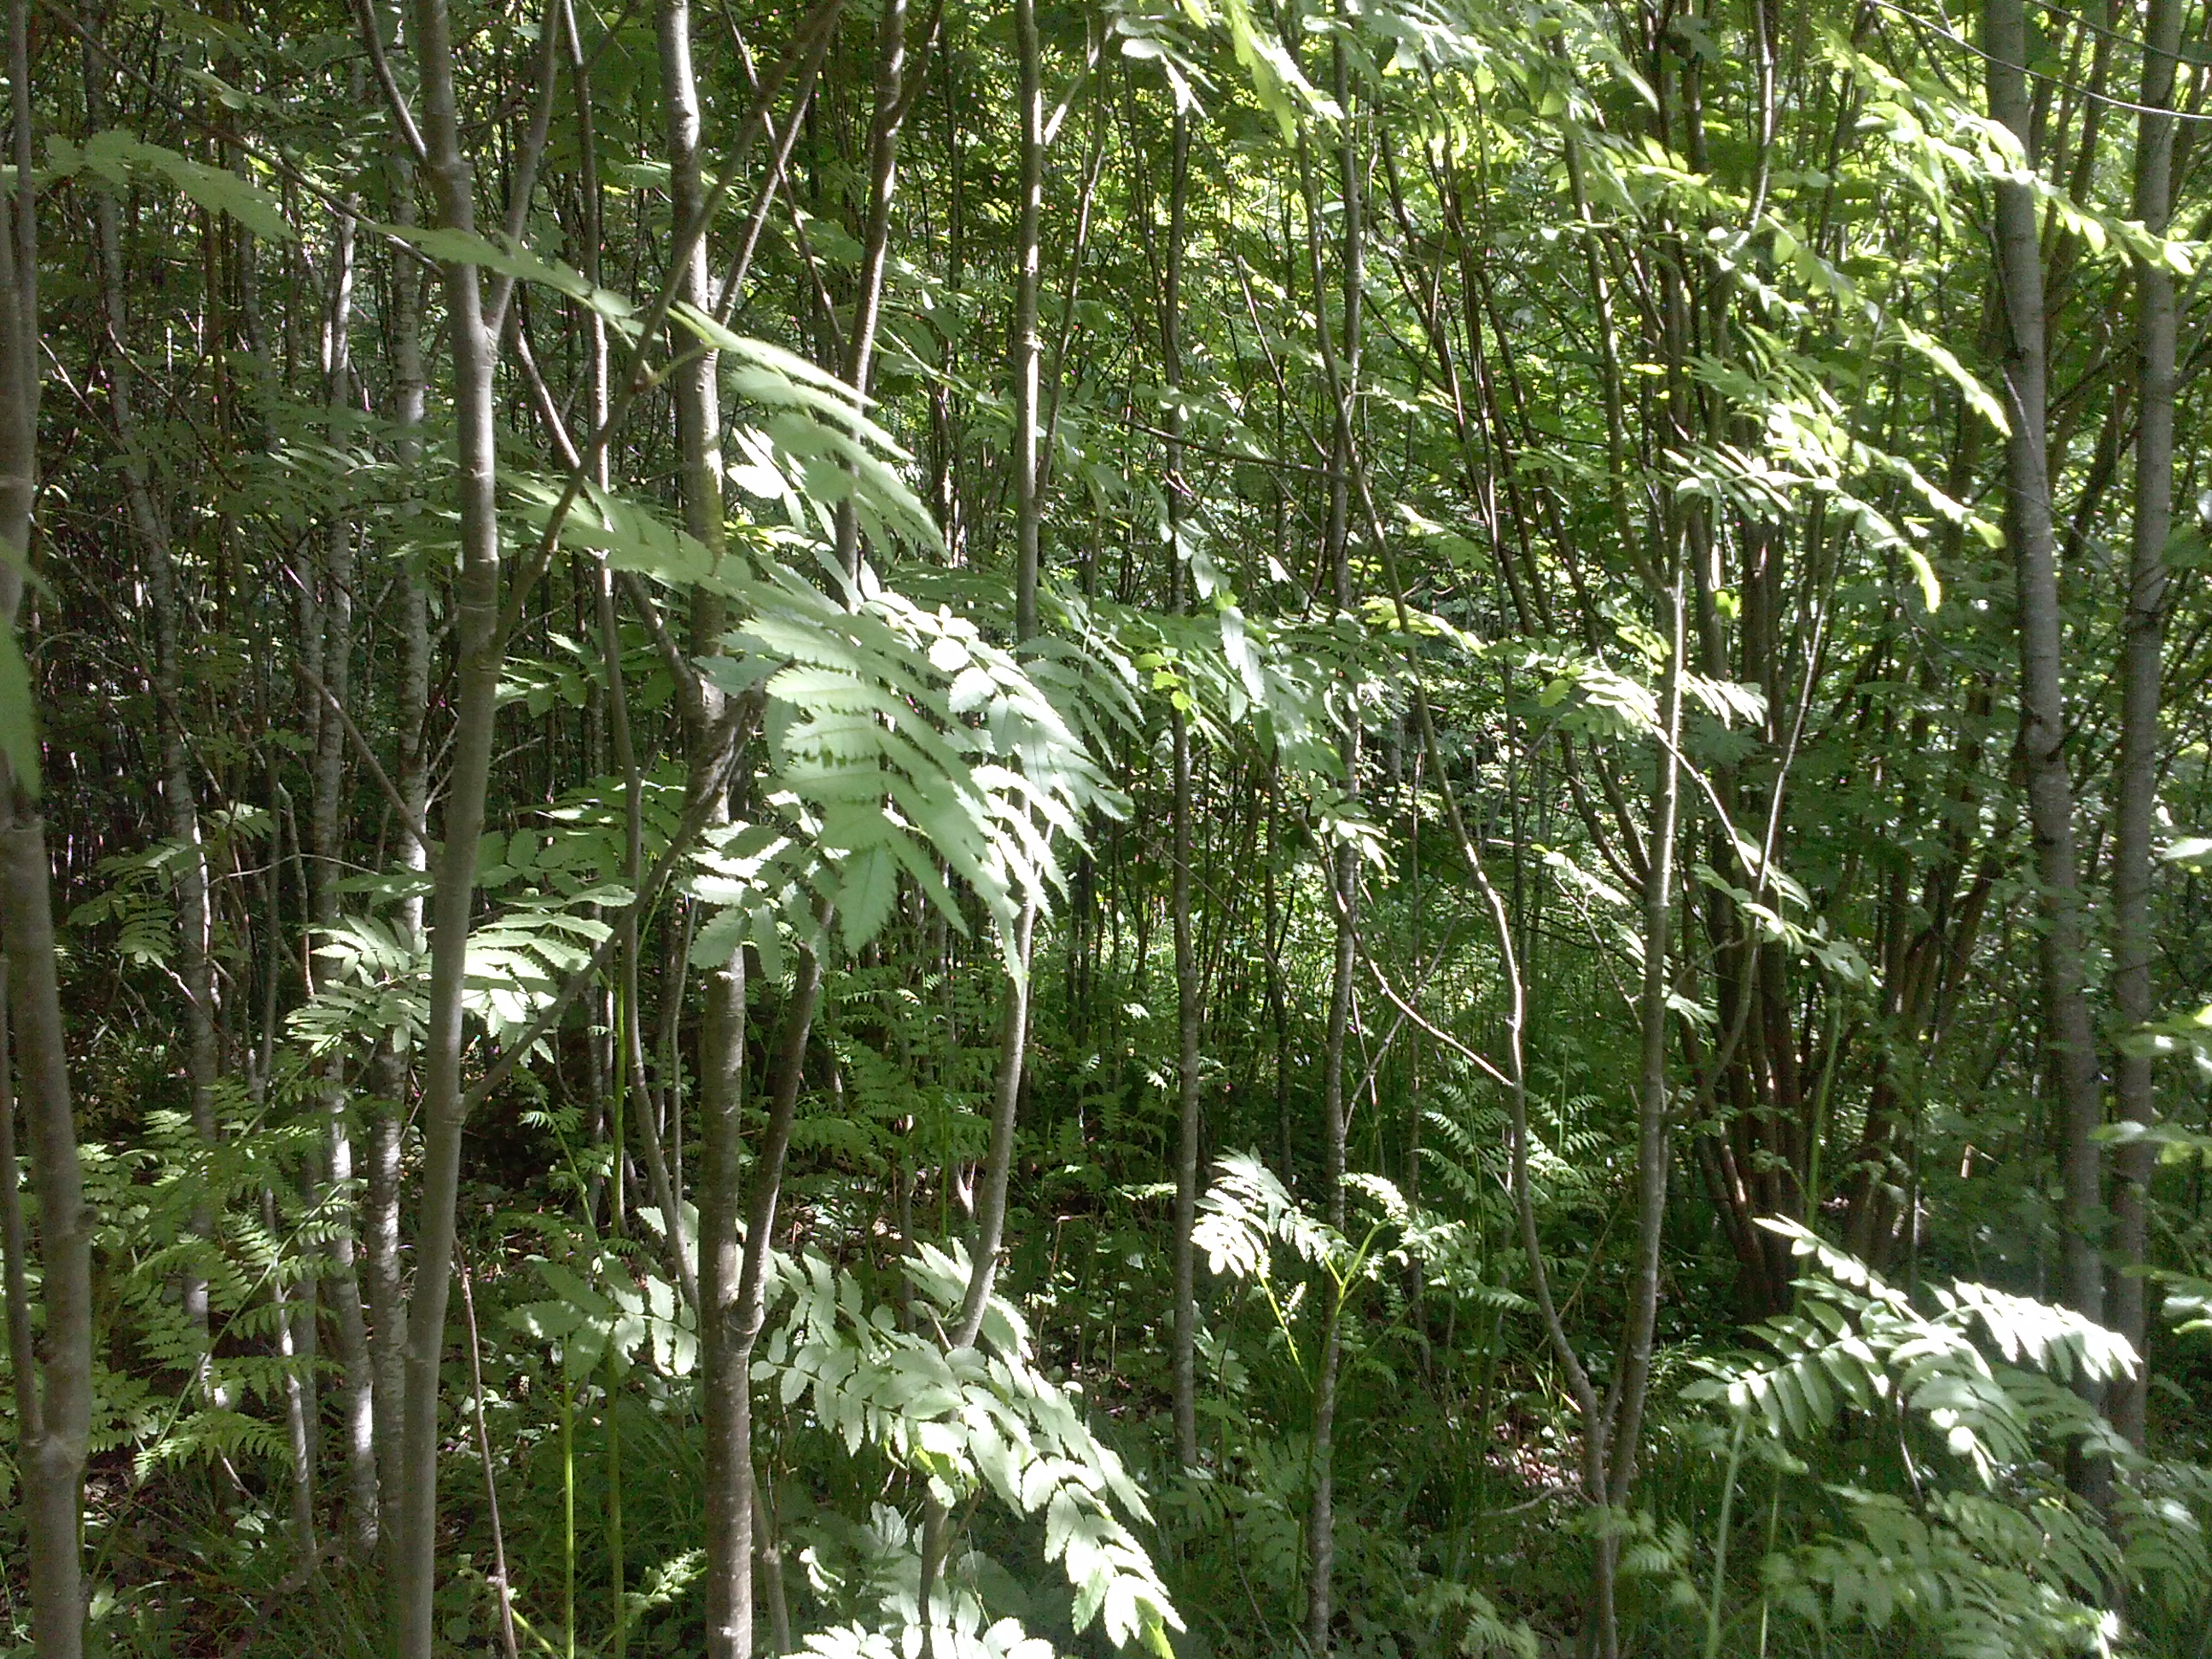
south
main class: Woodland
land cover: Broadleaved woodland
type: non-riverine alder, birch or aspen forest
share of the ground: > 75 %
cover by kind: broadleaved forest trees 100 %
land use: Forestry
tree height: > 5 m
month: June
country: LV
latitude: 56.4052
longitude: 27.4023
